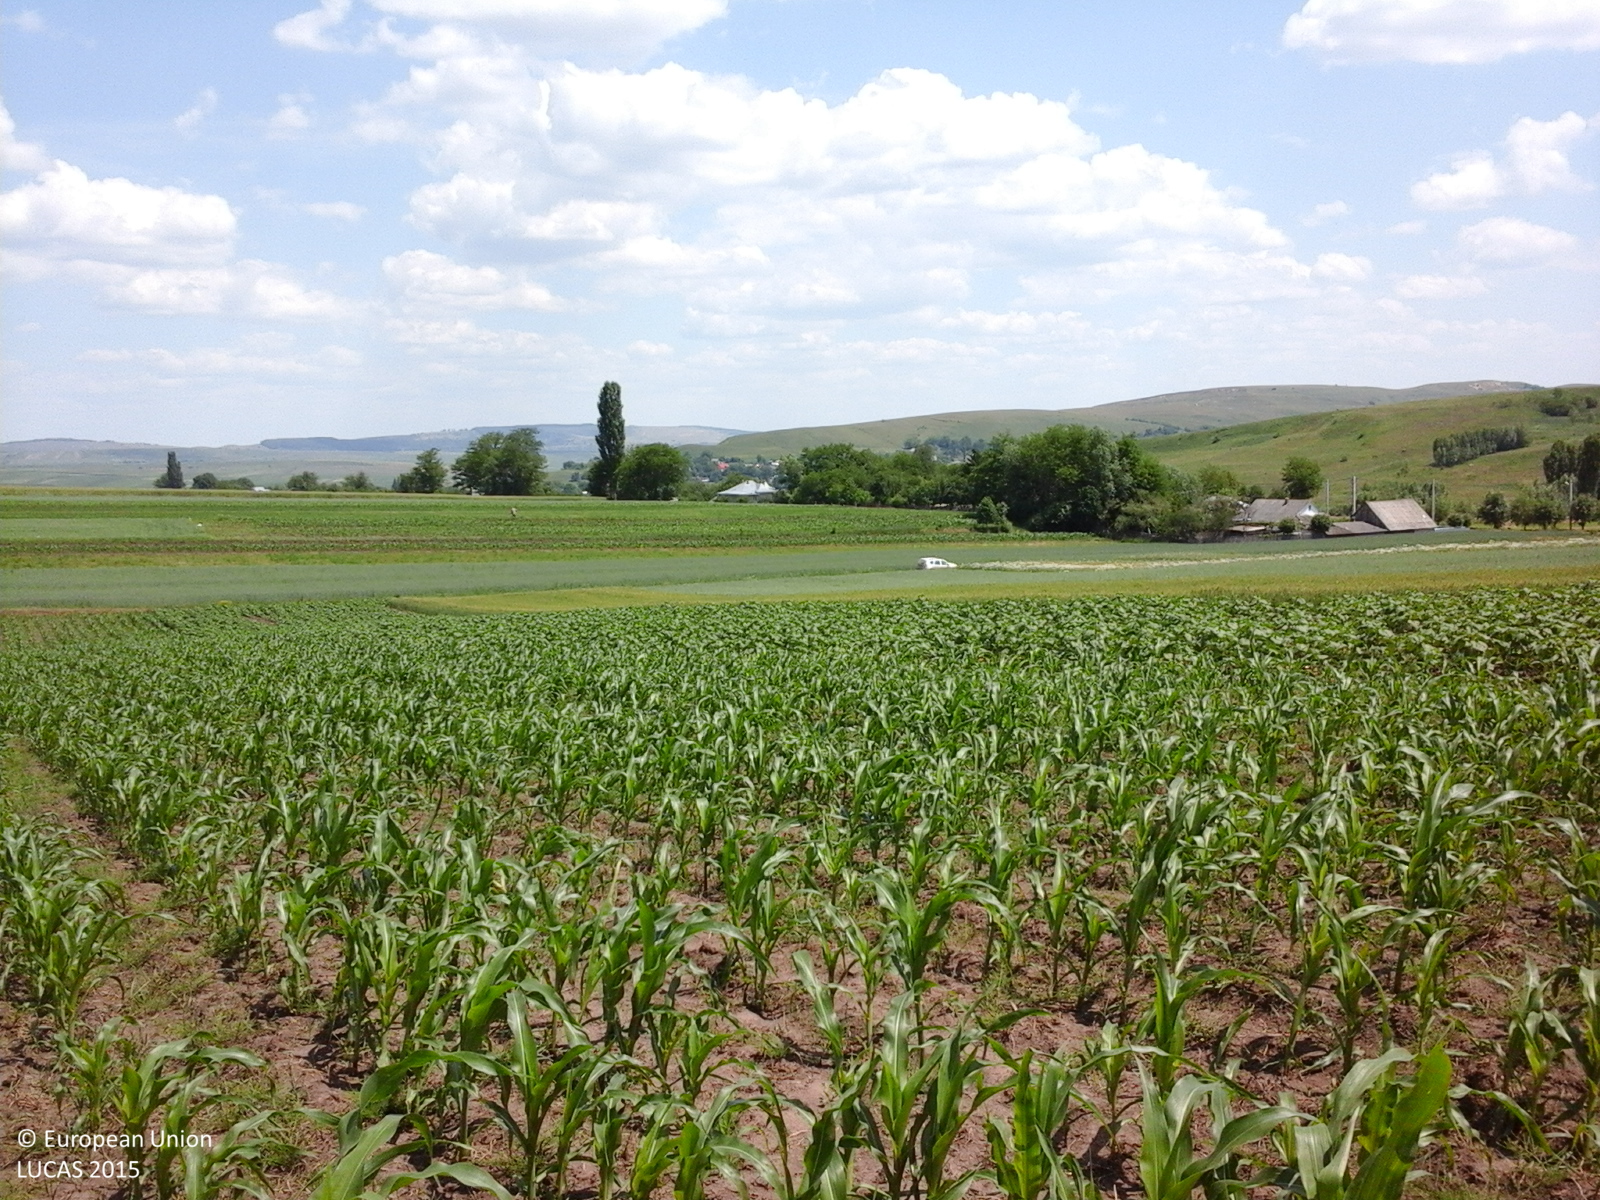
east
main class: Cropland
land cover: Maize
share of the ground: 25 - 50 %
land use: Agriculture (excluding fallow land and kitchen gardens)
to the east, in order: Maize; Grass margins; Sunflower; Common wheat; Oats; Grass margins; Tracks; Grass margins; Common wheat; Lucerne; Maize; Potatoes; Maize; Clovers; Potatoes; Maize
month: June
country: RO
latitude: 47.5314
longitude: 26.3024
